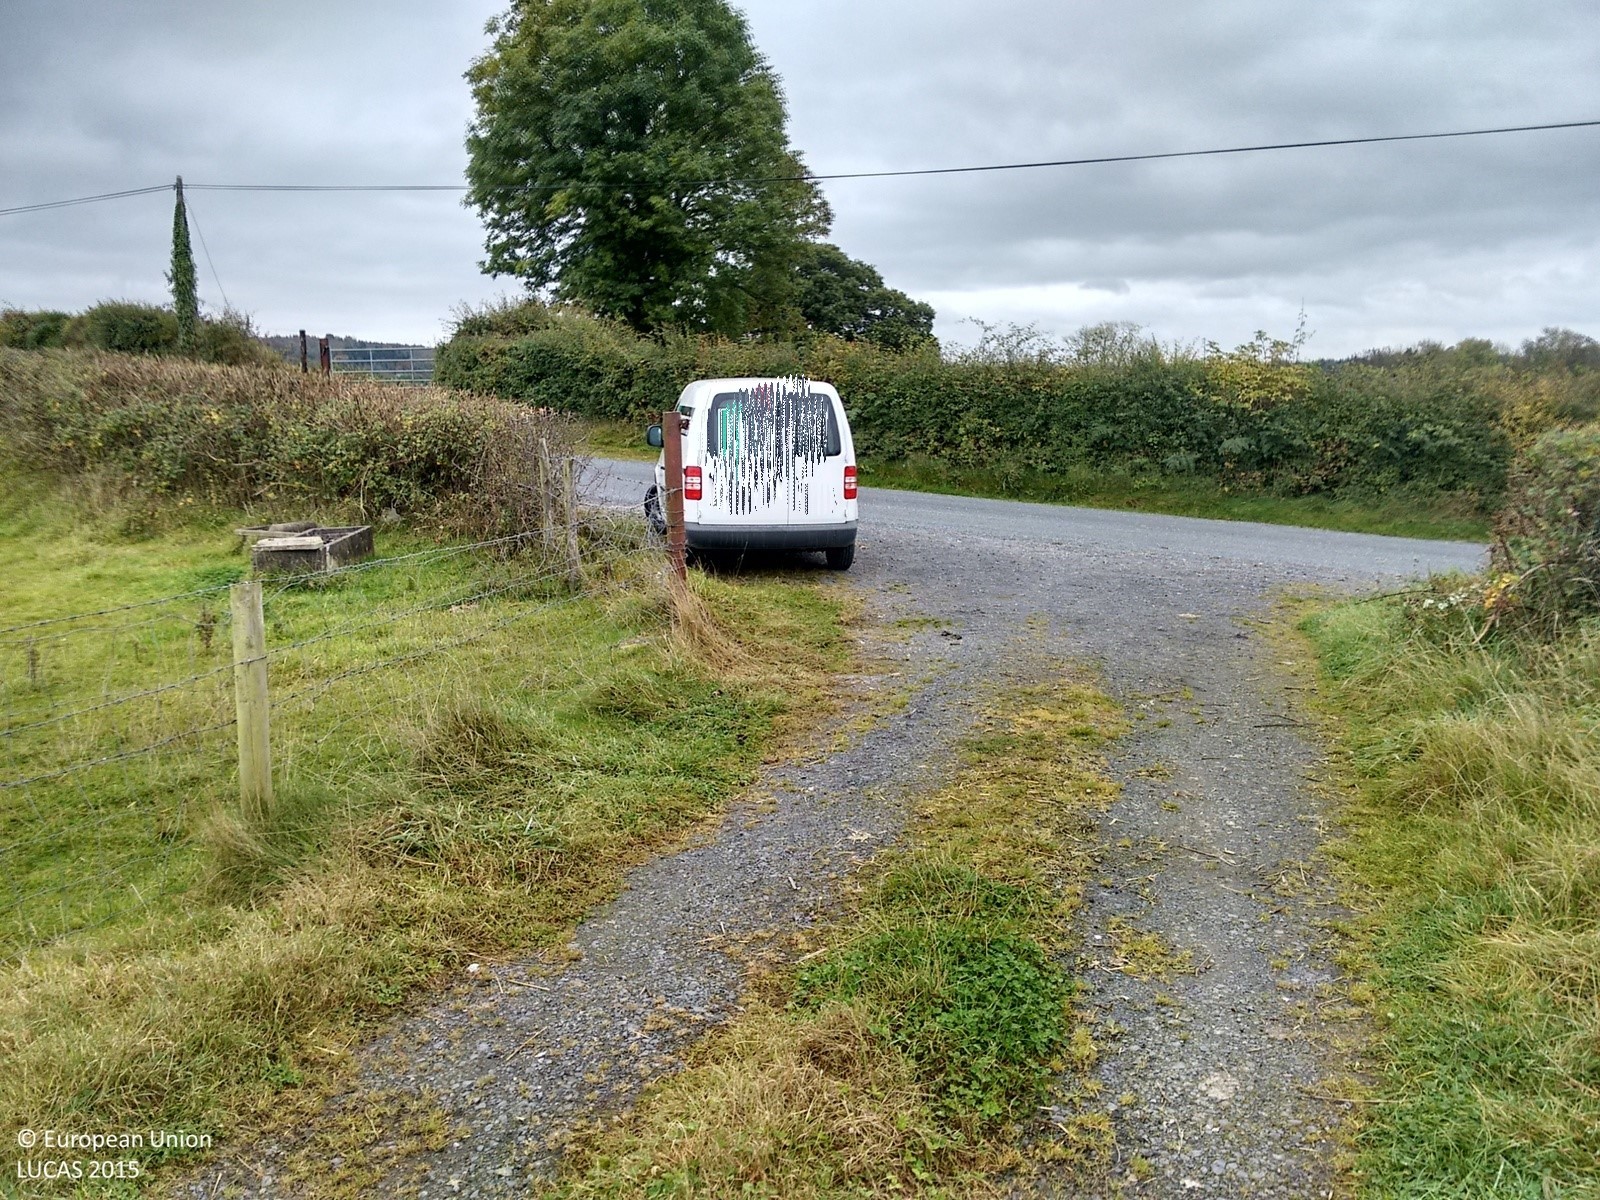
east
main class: Grassland
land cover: Grassland without tree/shrub cover
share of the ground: > 75 %
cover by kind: herbaceous plants 100 %
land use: Agriculture (excluding fallow land and kitchen gardens)
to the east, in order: Grassland without tree/shrub cover; Fences; Grassland without tree/shrub cover; Artificial constructions in urban areas; Managed hedges; Electric lines; Fences; Grassland without tree/shrub cover
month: October
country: IE
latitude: 52.9946
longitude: -7.8863
